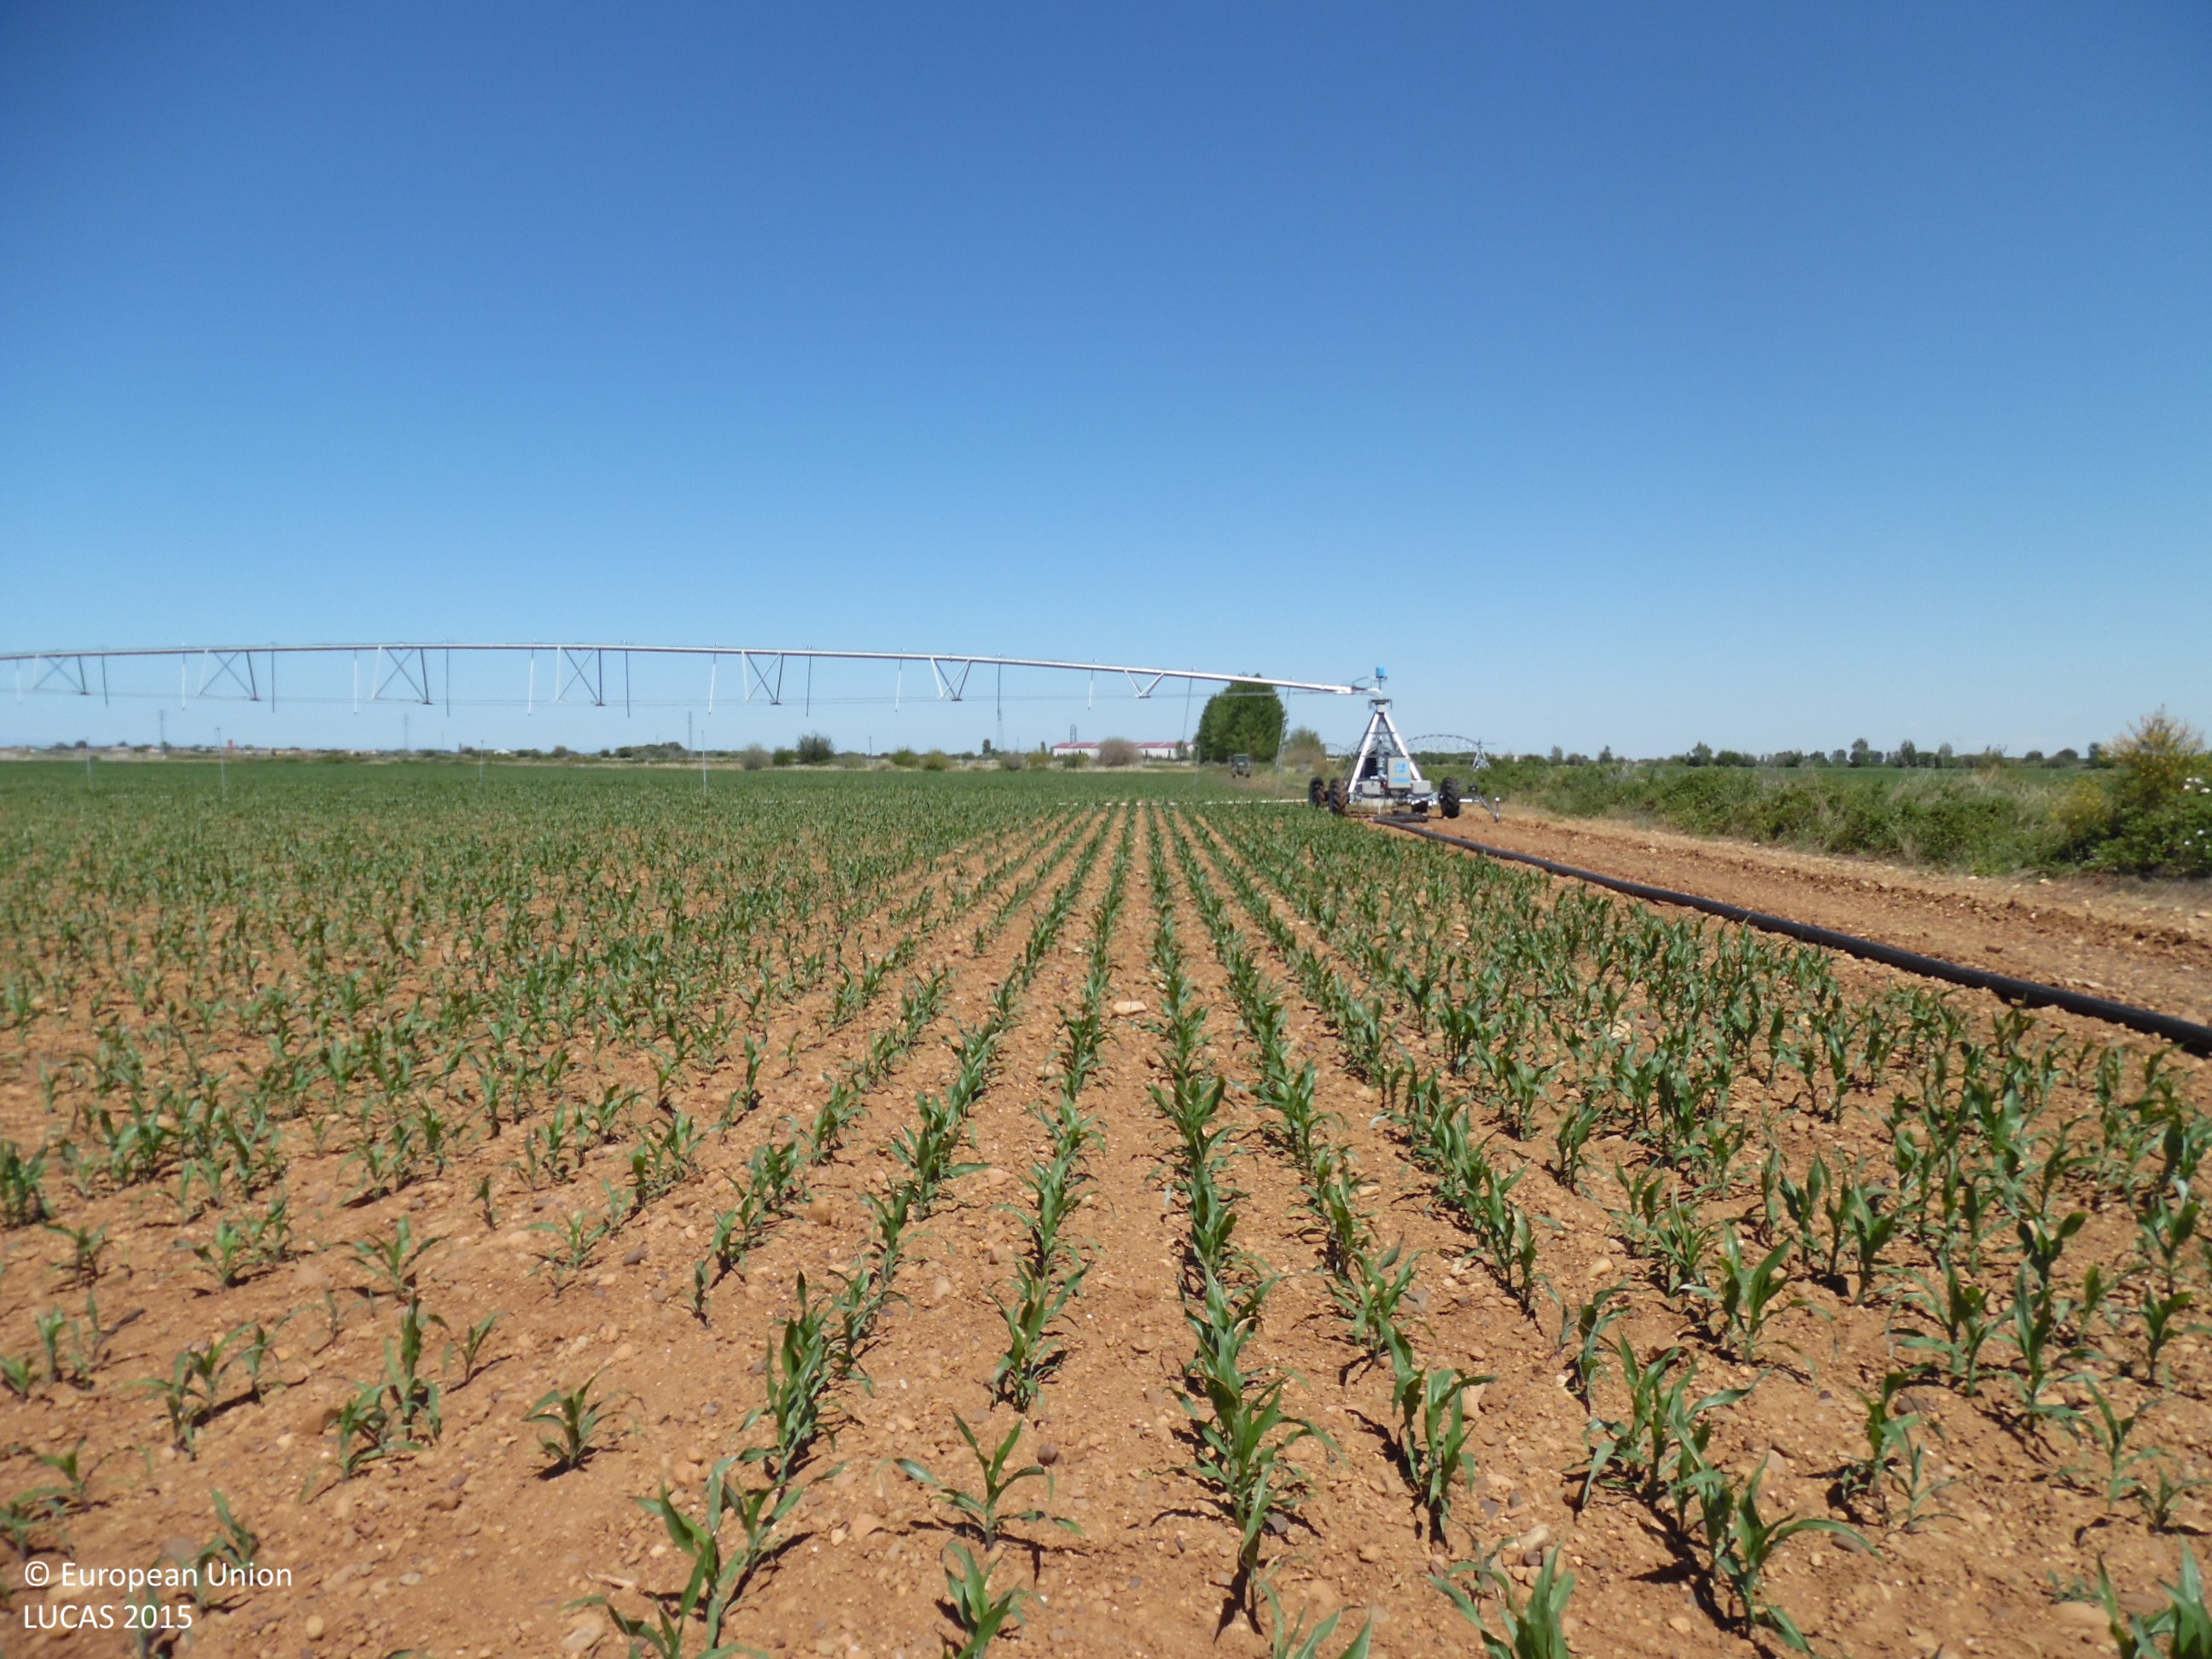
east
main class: Cropland
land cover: Maize
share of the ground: 50 - 75 %
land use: Agriculture (excluding fallow land and kitchen gardens)
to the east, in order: Maize; Shruby margins; Ditches and canals; Shruby margins; Tracks; Grass margins; Ditches and canals; Maize
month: June
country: ES
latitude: 42.4029
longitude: -5.7597
